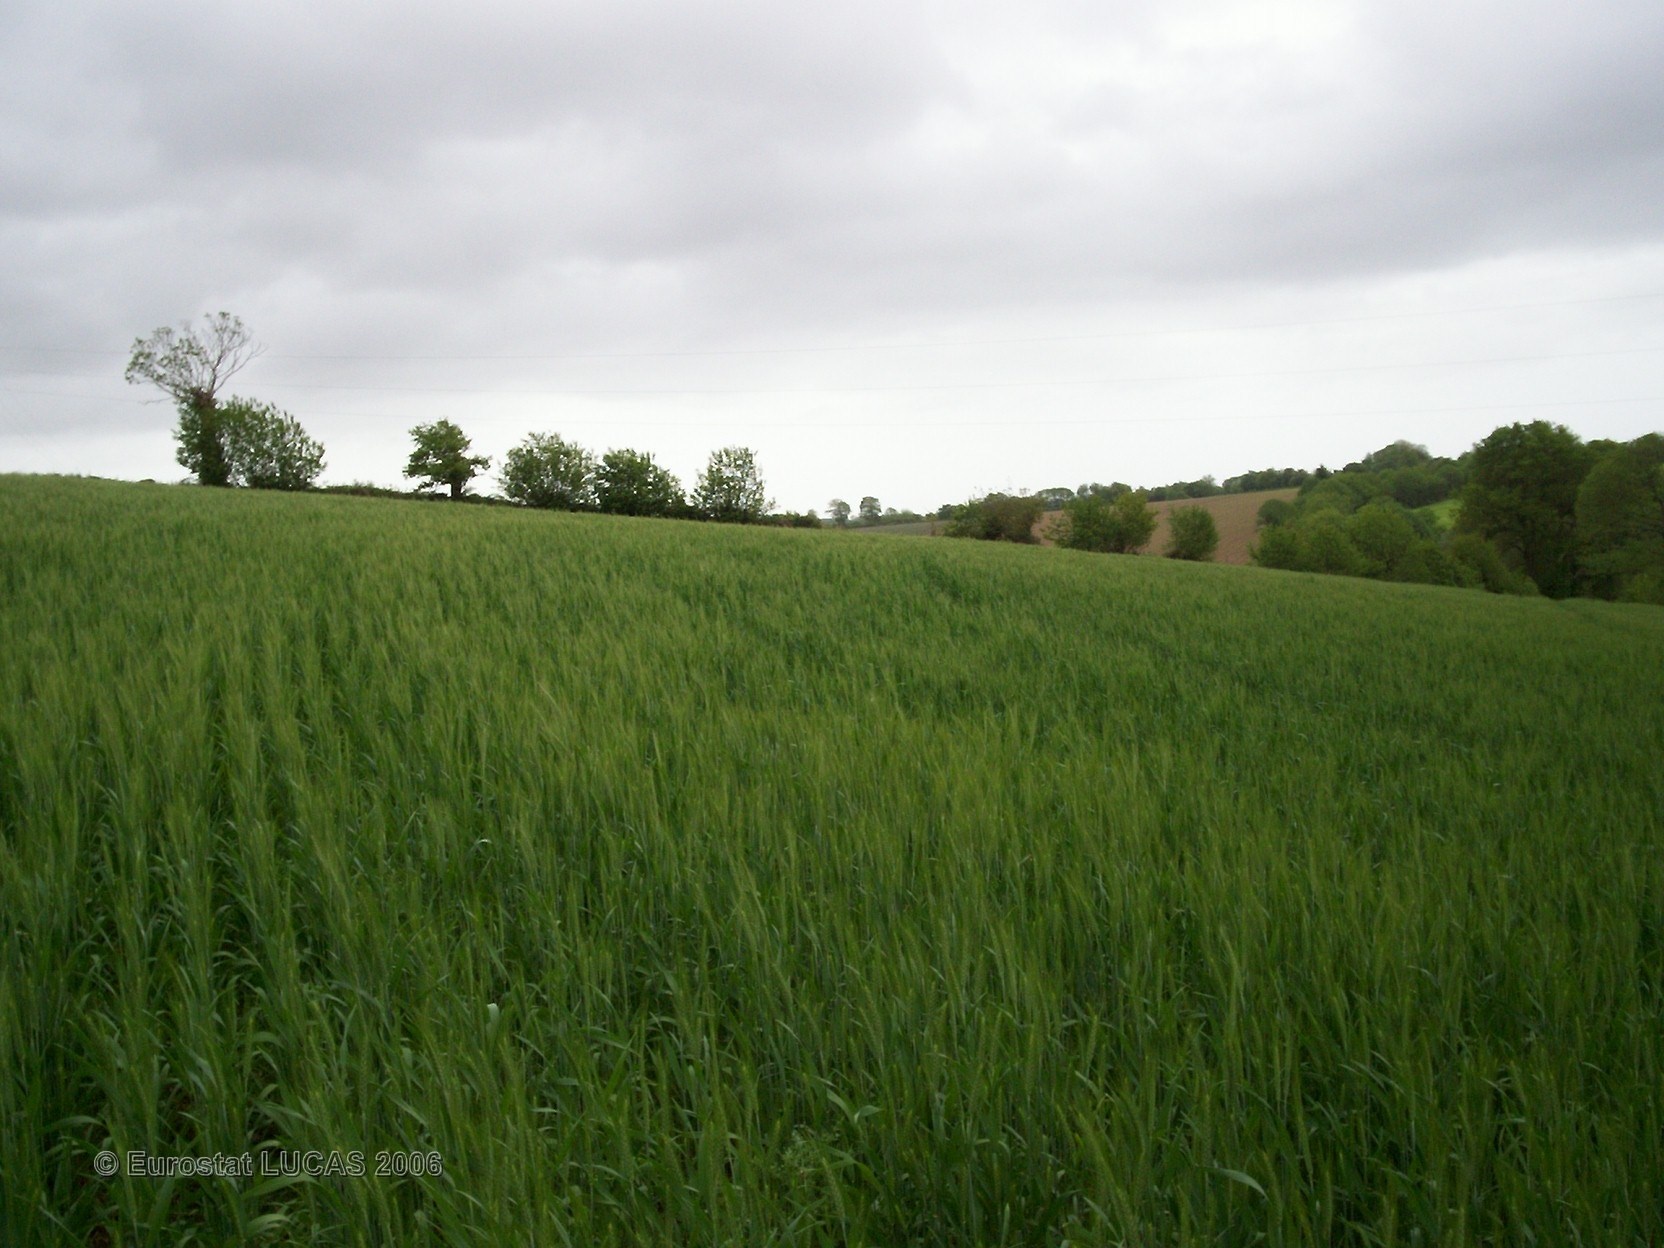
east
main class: Cropland
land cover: Common wheat
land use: Agriculture (excluding fallow land and kitchen gardens)
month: May
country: FR
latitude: 47.9242
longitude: -3.8814
